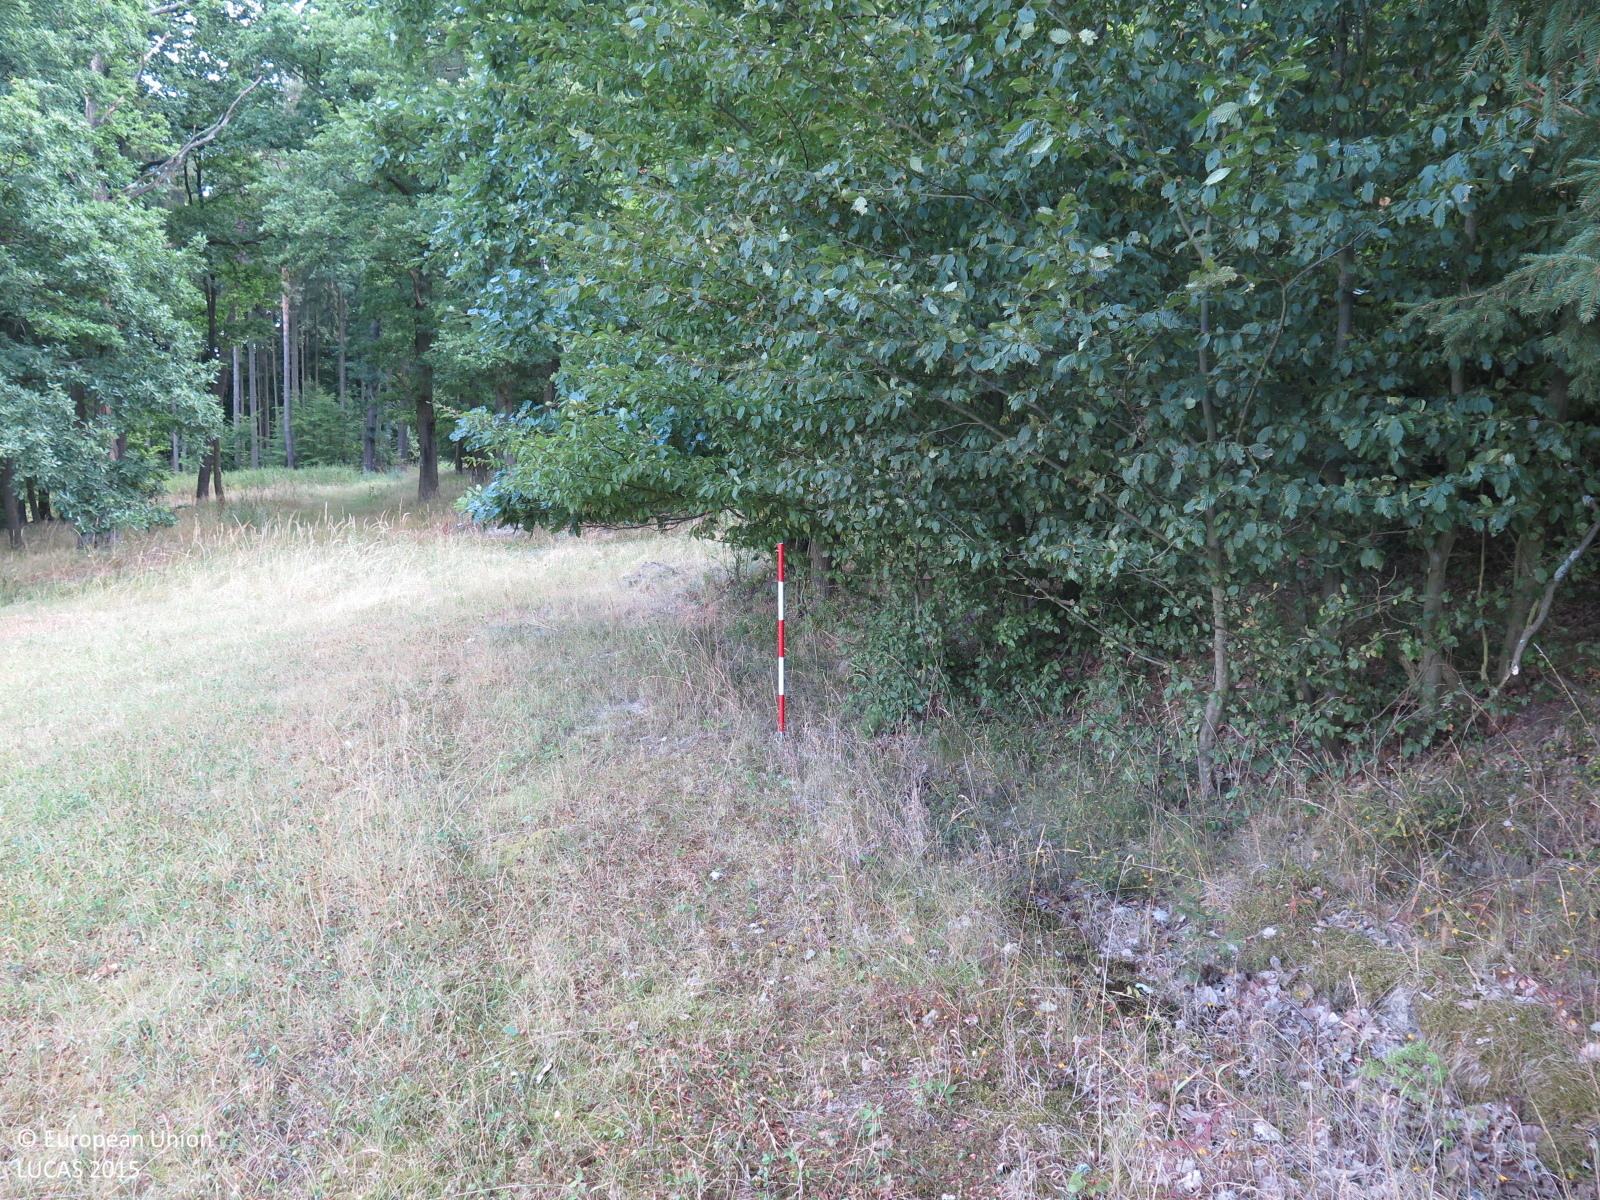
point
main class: Grassland
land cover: Grassland without tree/shrub cover
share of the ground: > 75 %
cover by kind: herbaceous plants 100 %
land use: Agriculture (excluding fallow land and kitchen gardens)
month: August
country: CZ
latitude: 50.0476
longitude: 13.8410
